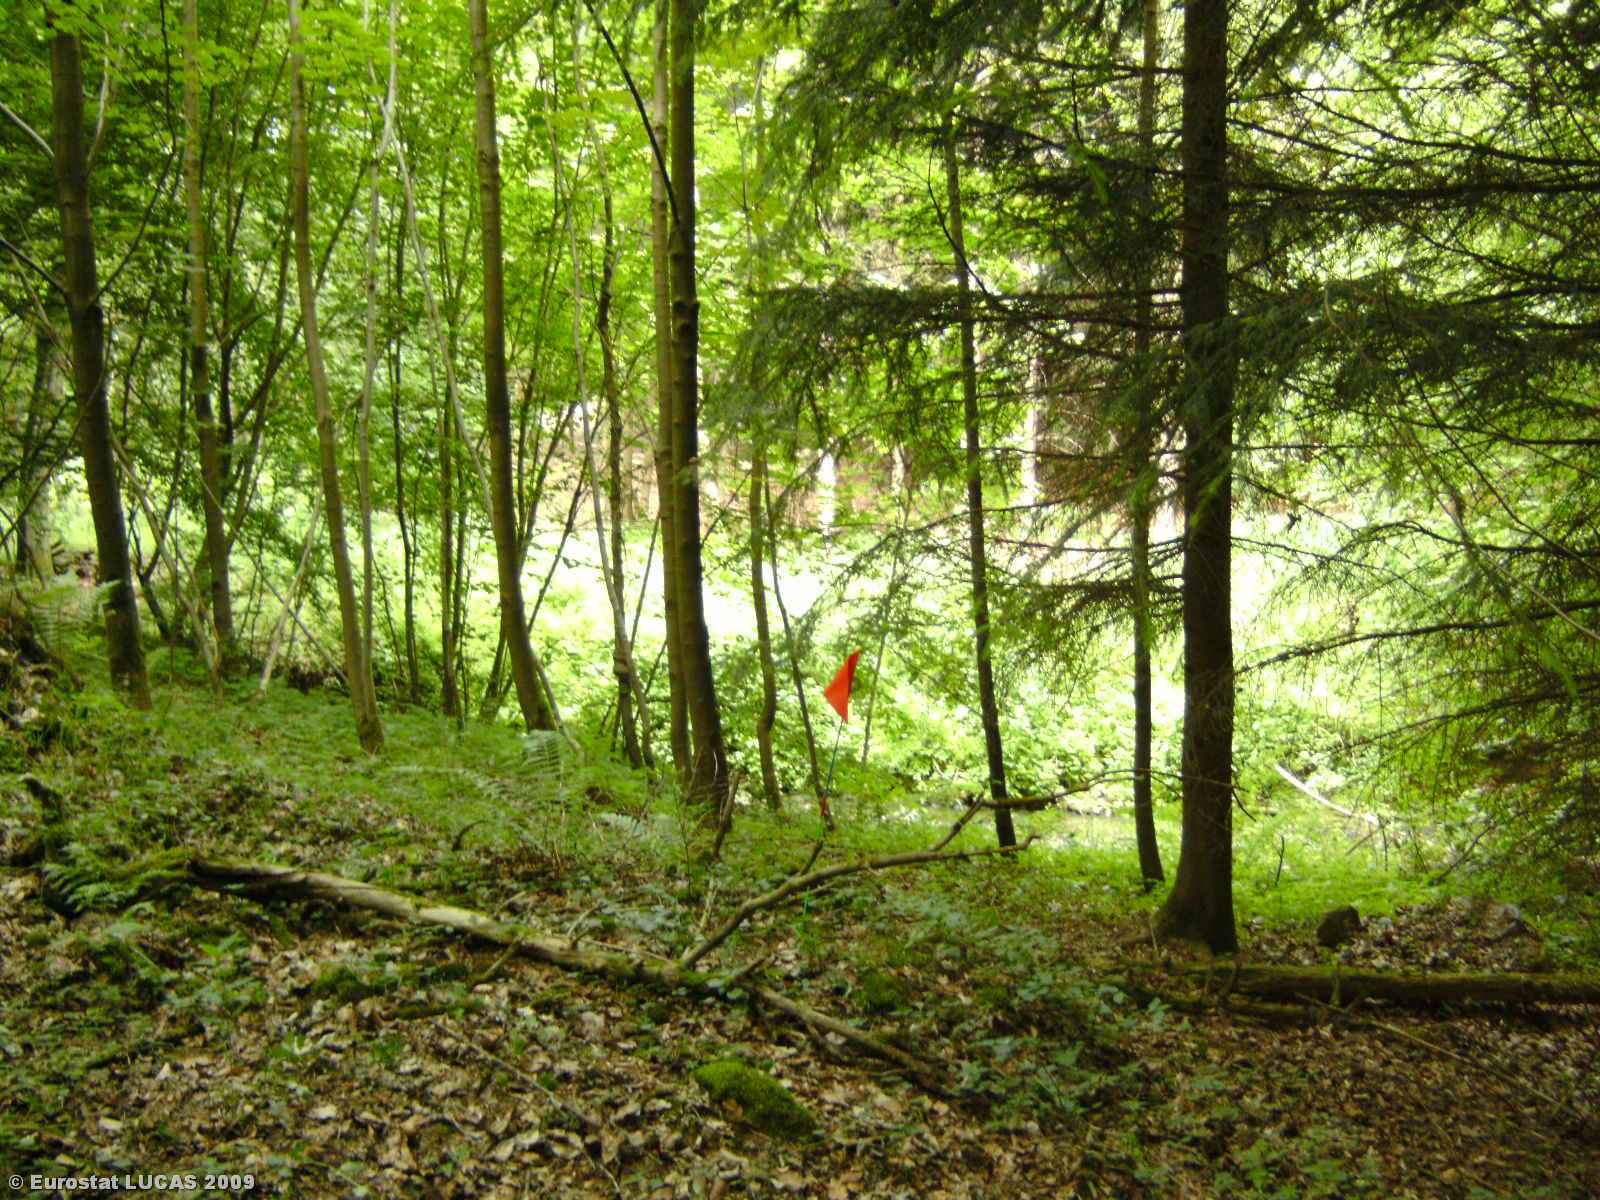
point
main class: Woodland
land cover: Broadleaved woodland
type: hemiboreal forest and nemoral coniferous forest and mixed broadleaved-coniferous forest
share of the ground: > 75 %
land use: Forestry
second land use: Amenities, museums, leisure
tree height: > 5 m
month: June
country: LU
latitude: 49.5788
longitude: 6.1408
